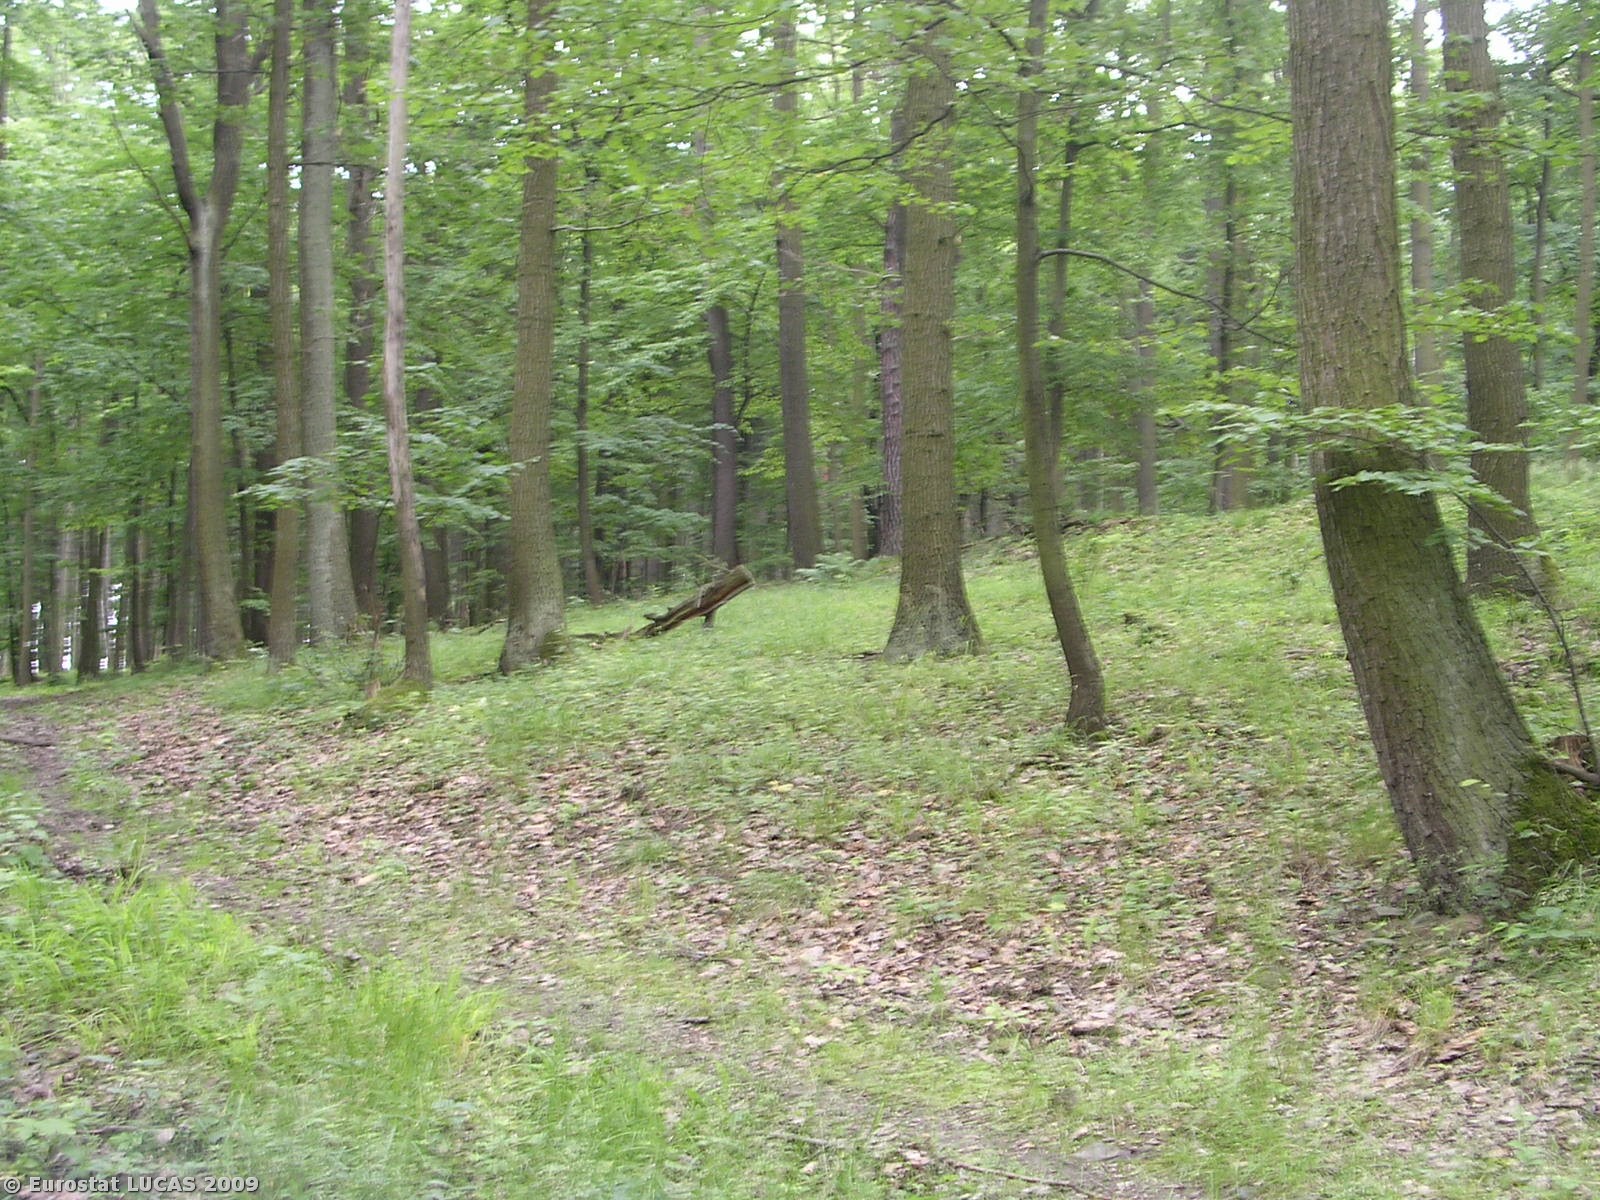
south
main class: Woodland
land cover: Broadleaved woodland
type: acidophilous oak and oak-birch forest
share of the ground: > 75 %
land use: Forestry
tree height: > 5 m
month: June
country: CZ
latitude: 50.5932
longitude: 14.1968
